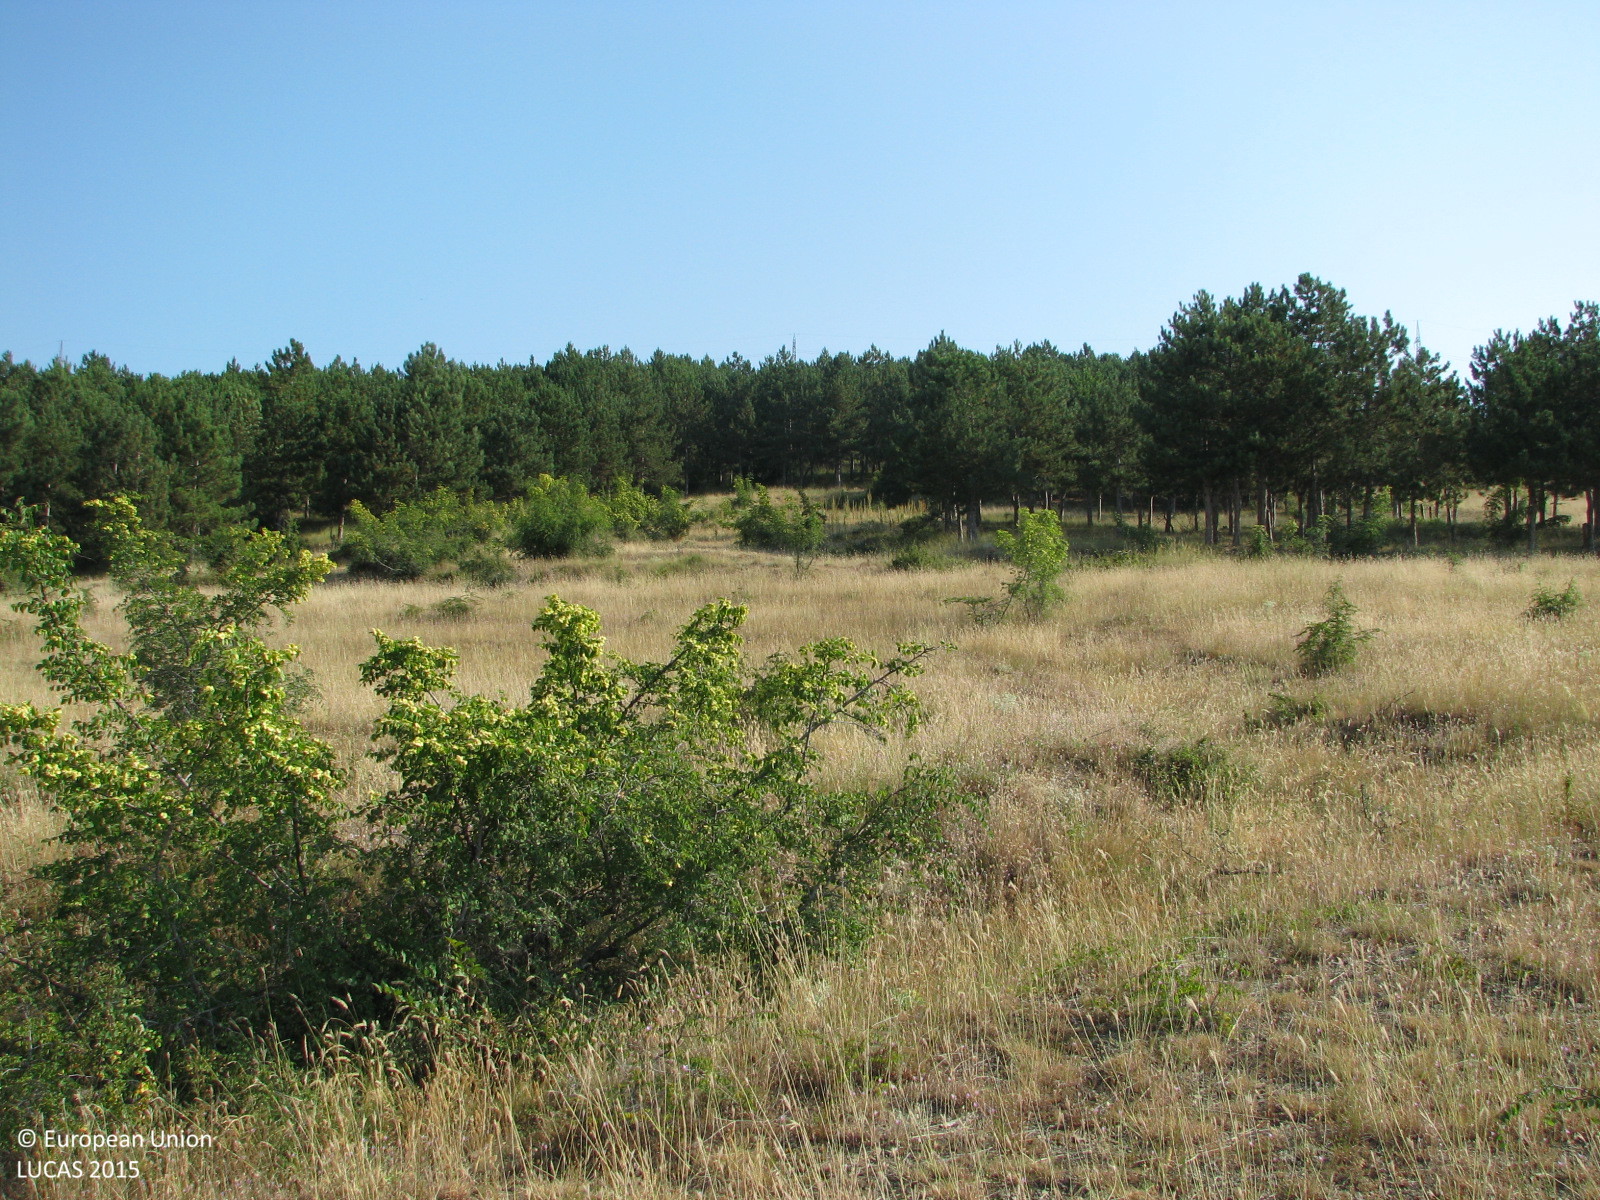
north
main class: Grassland
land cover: Grassland with sparse tree/shrub cover
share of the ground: > 75 %
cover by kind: herbaceous plants 90 %, broadleaved forest trees 5 %, shrubs 5 %
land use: Agriculture (excluding fallow land and kitchen gardens)
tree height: < 5 m
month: July
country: BG
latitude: 42.6526
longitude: 26.1512
